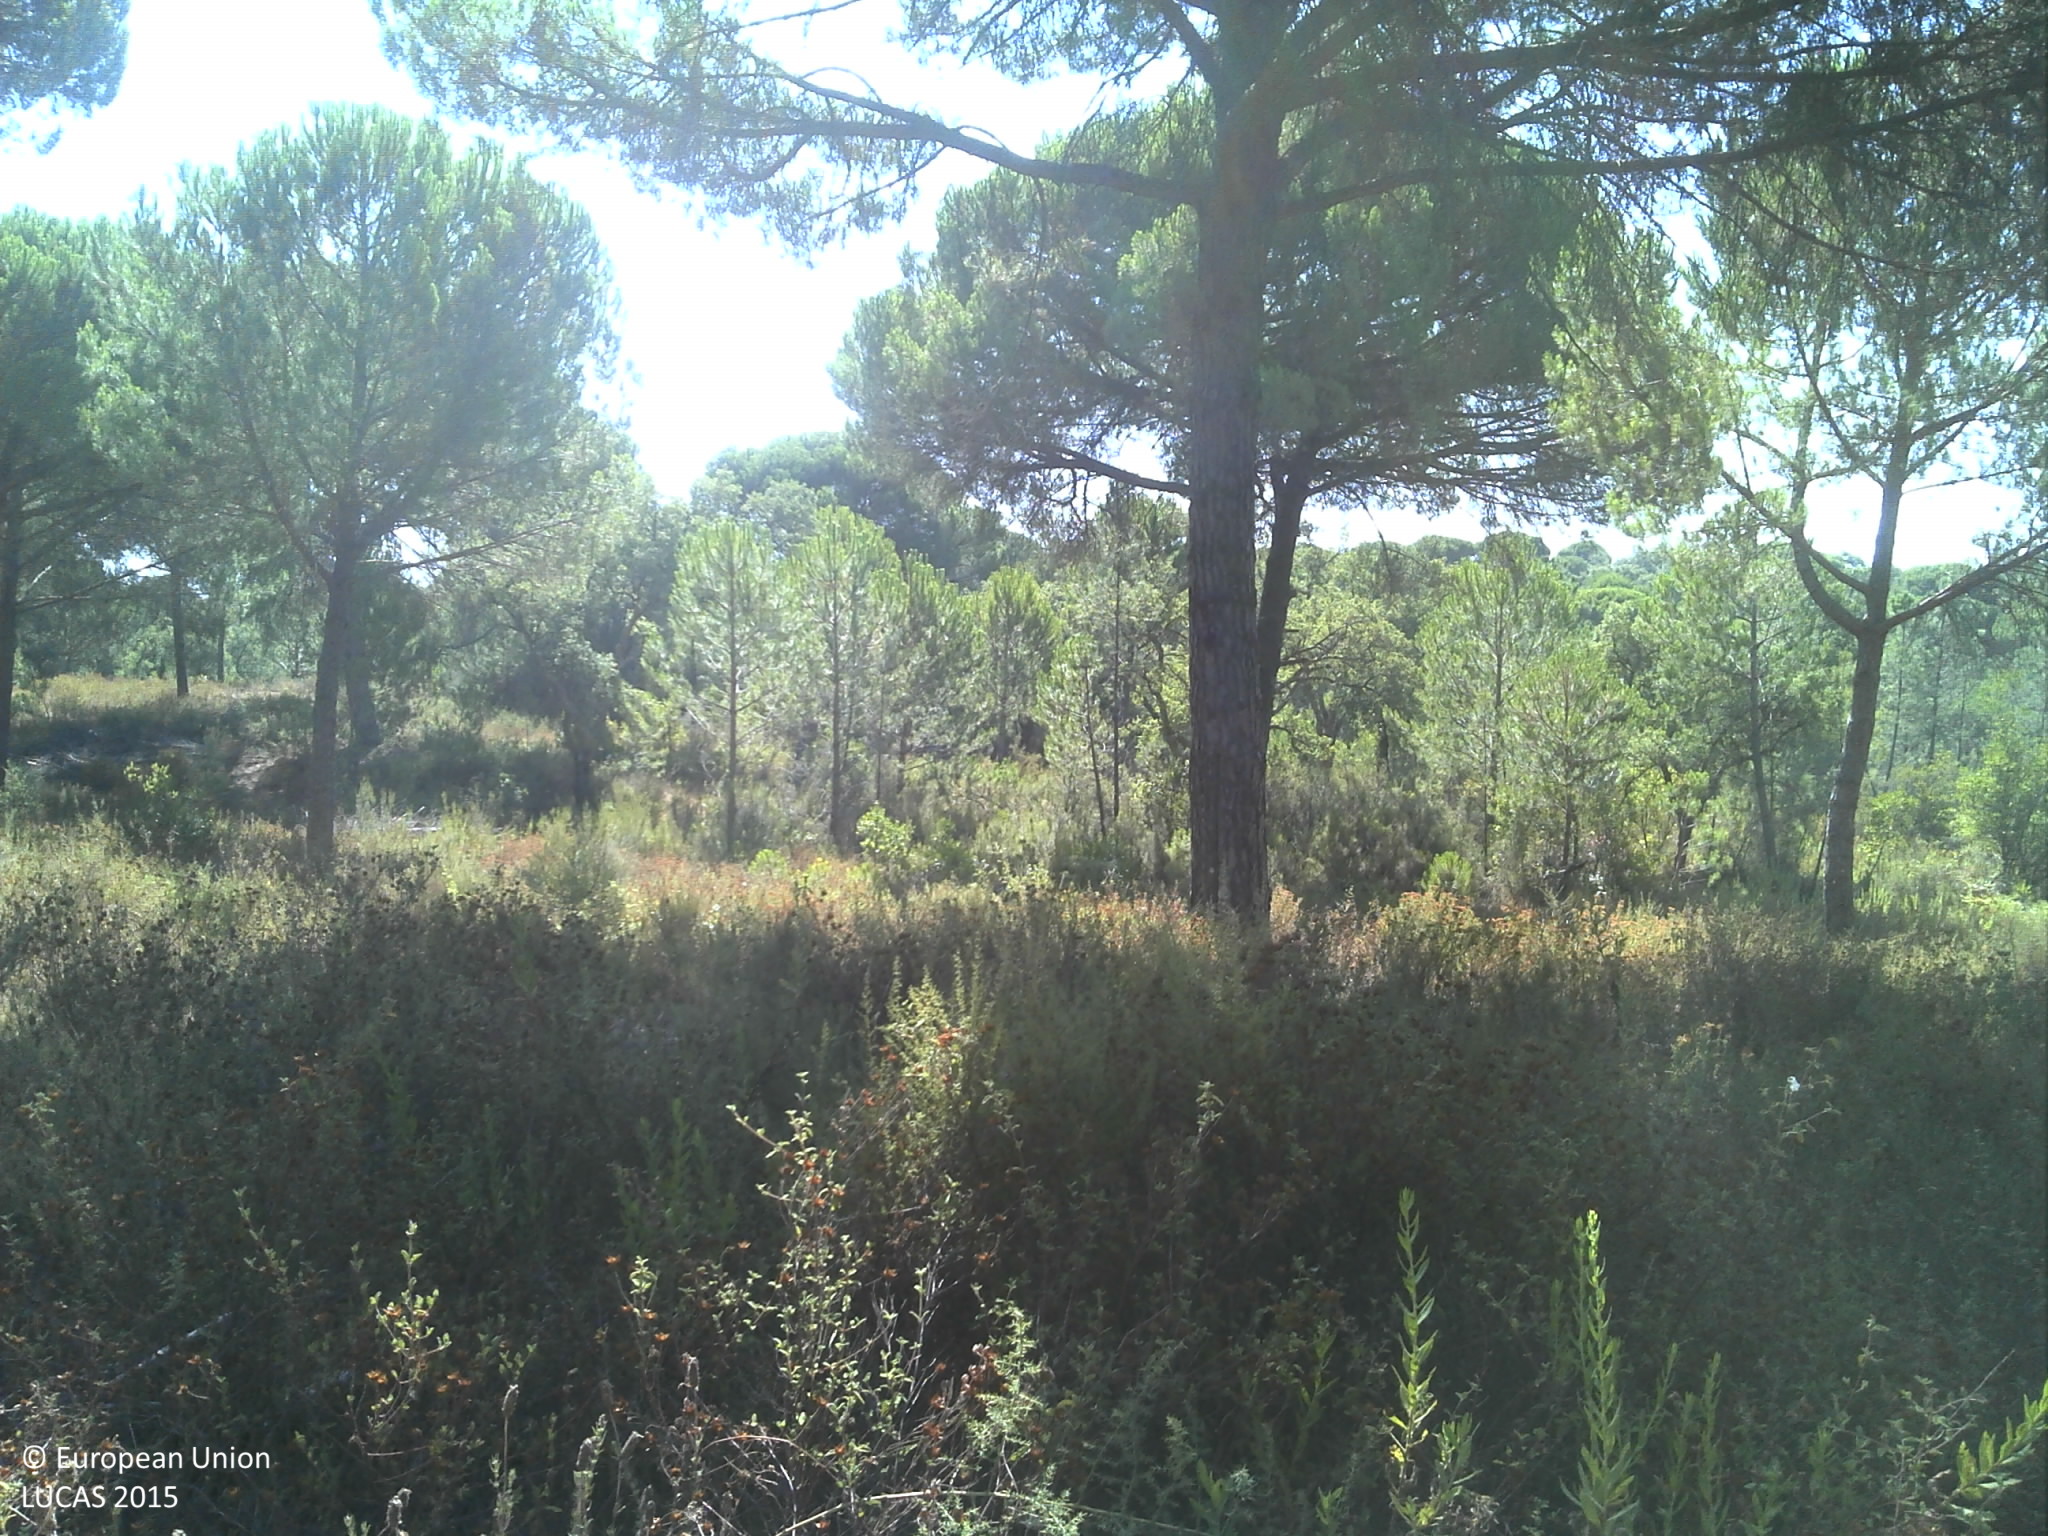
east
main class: Woodland
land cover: Pine dominated coniferous woodland
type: coniferous forest of the mediterranean region
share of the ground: 25 - 50 %
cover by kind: coniferous forest trees 45 %, unconsolidated bare surface 30 %, herbaceous plants 15 %, shrubs 10 %
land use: Forestry
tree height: > 5 m
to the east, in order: Pine dominated coniferous woodland; Shrubland without tree cover; Rivers and streams; Shrubland without tree cover; Pine dominated coniferous woodland; Arable land (only in case pi); Broadleaved woodland
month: August
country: PT
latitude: 38.6440
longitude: -8.5670
